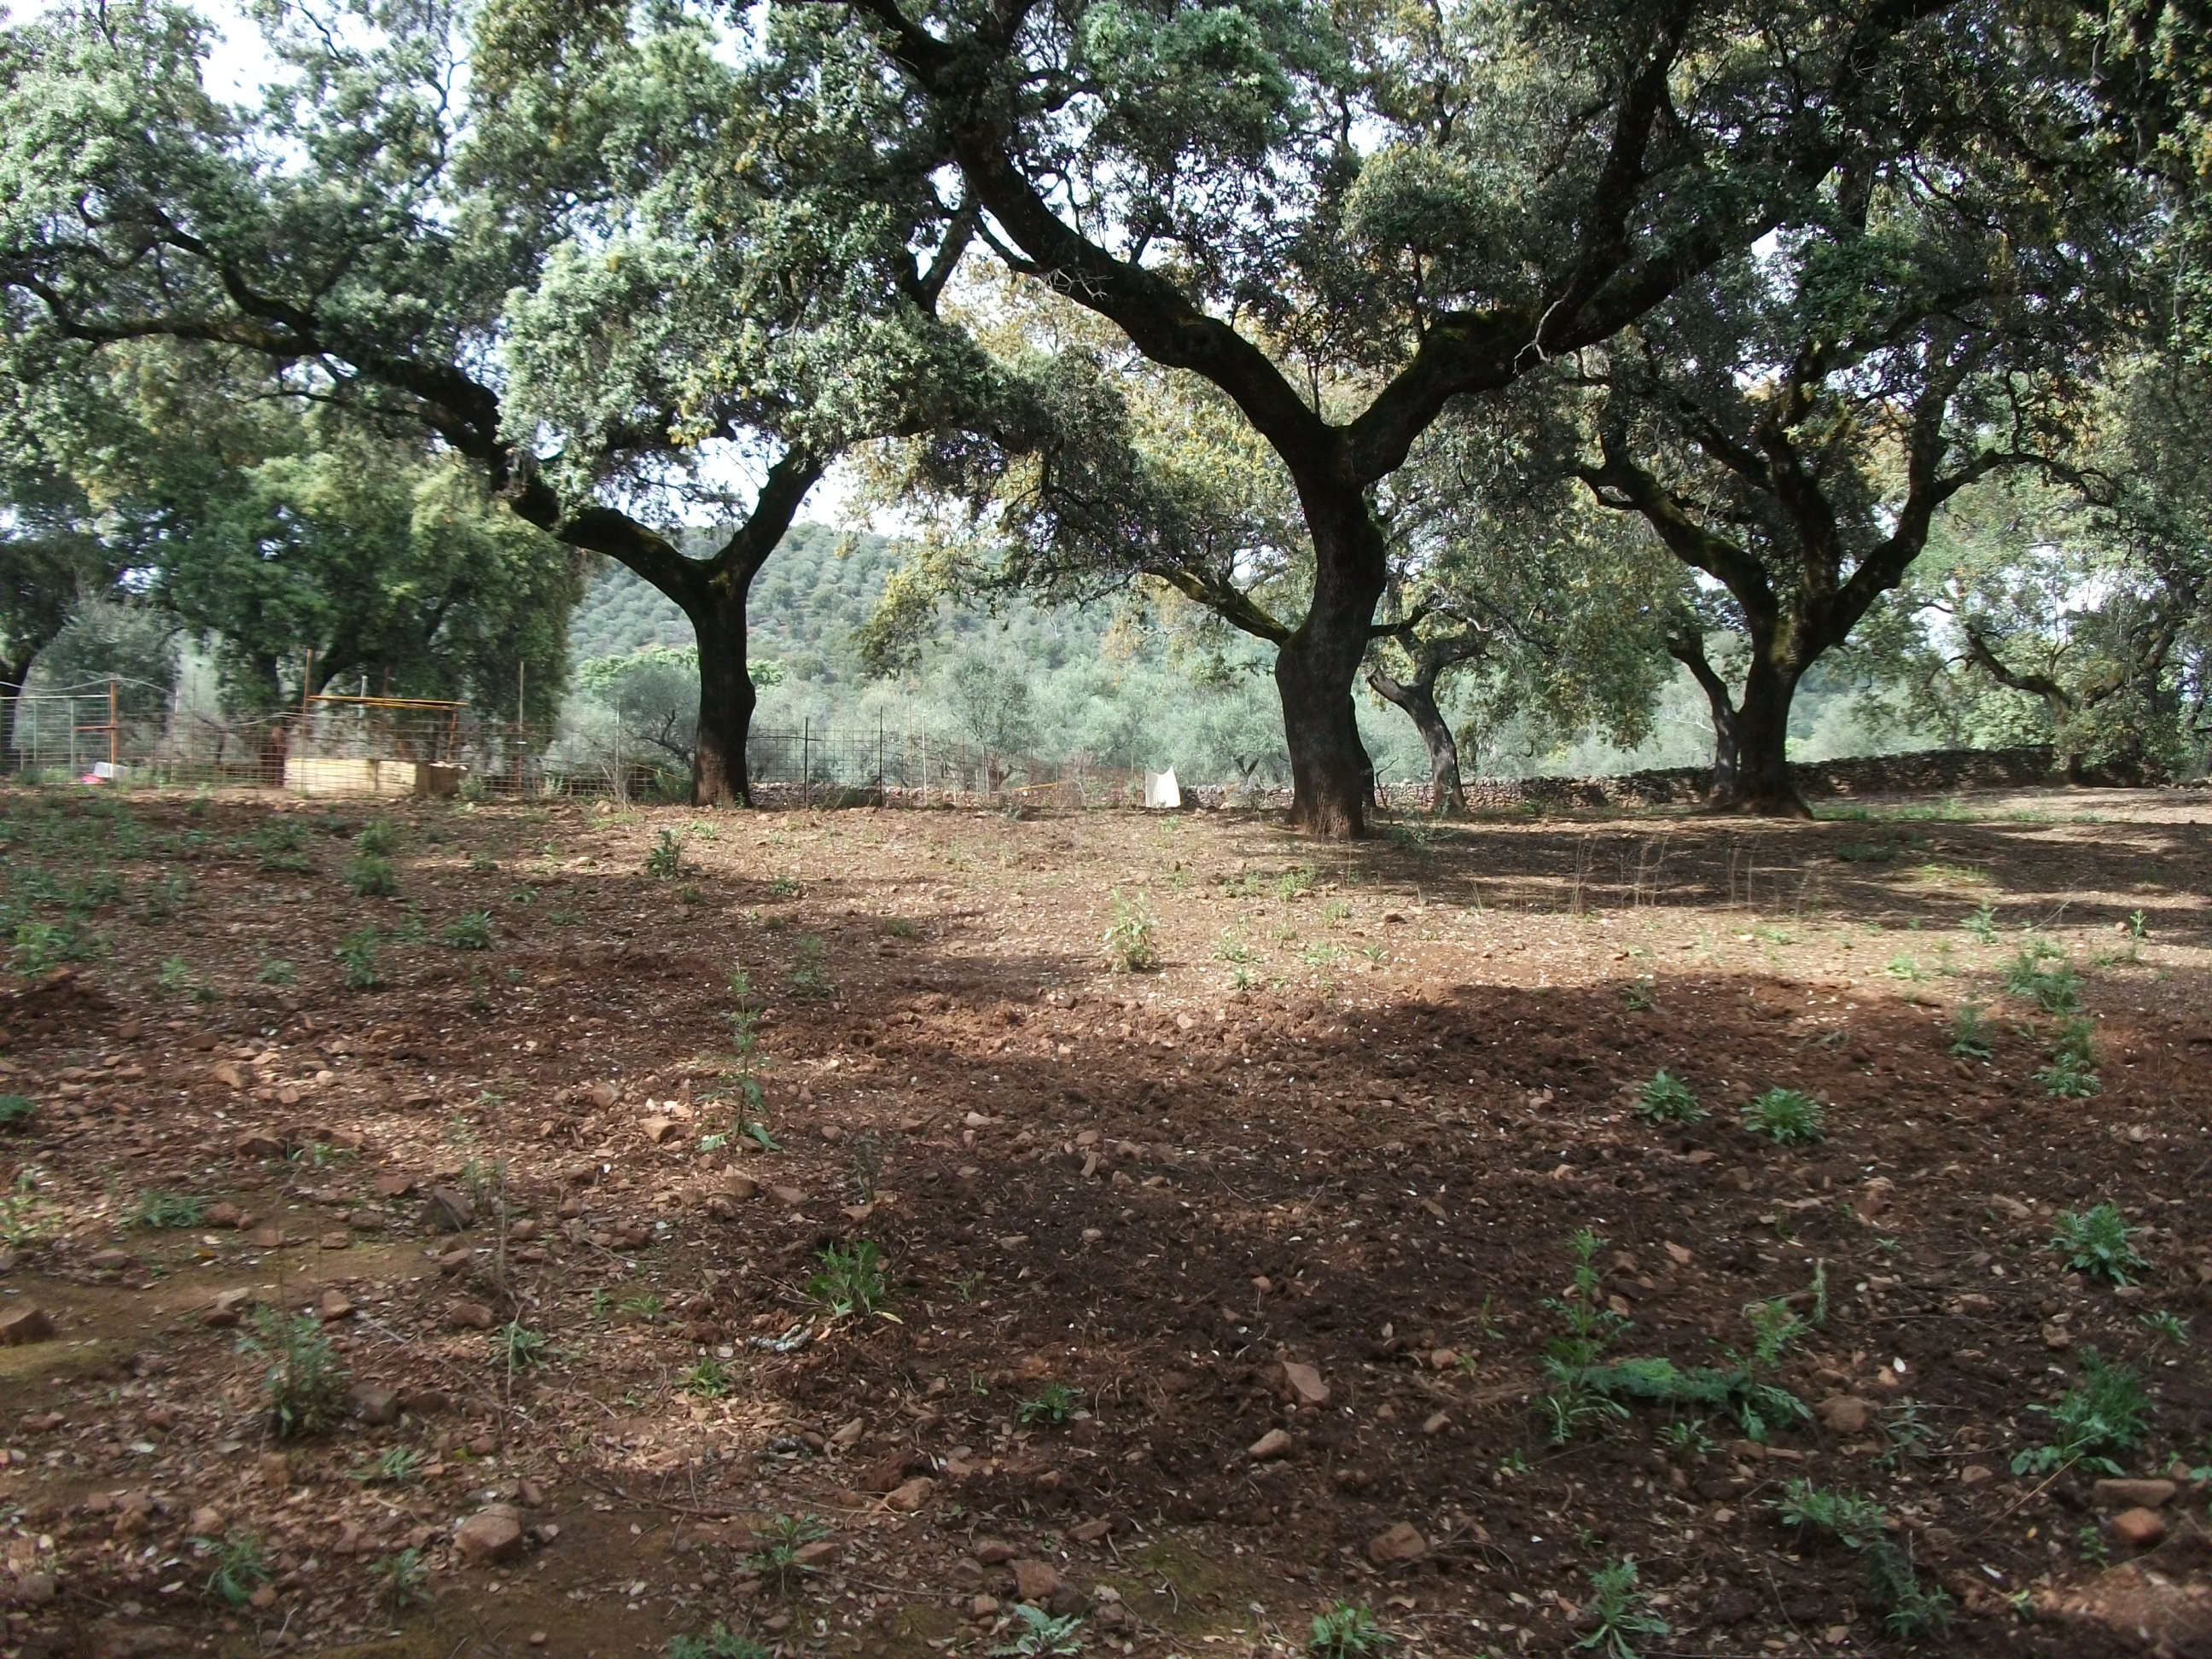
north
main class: Woodland
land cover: Broadleaved woodland
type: broadleaved evergreen forest
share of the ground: 50 - 75 %
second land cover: Spontaneously vegetated surfaces
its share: 10 - 25 %
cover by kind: broadleaved forest trees 80 %, herbaceous plants 10 %, unconsolidated bare surface 10 %
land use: Forestry
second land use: Agriculture (excluding fallow land and kitchen gardens)
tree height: > 5 m
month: April
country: ES
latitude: 37.8618
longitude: -6.5121
